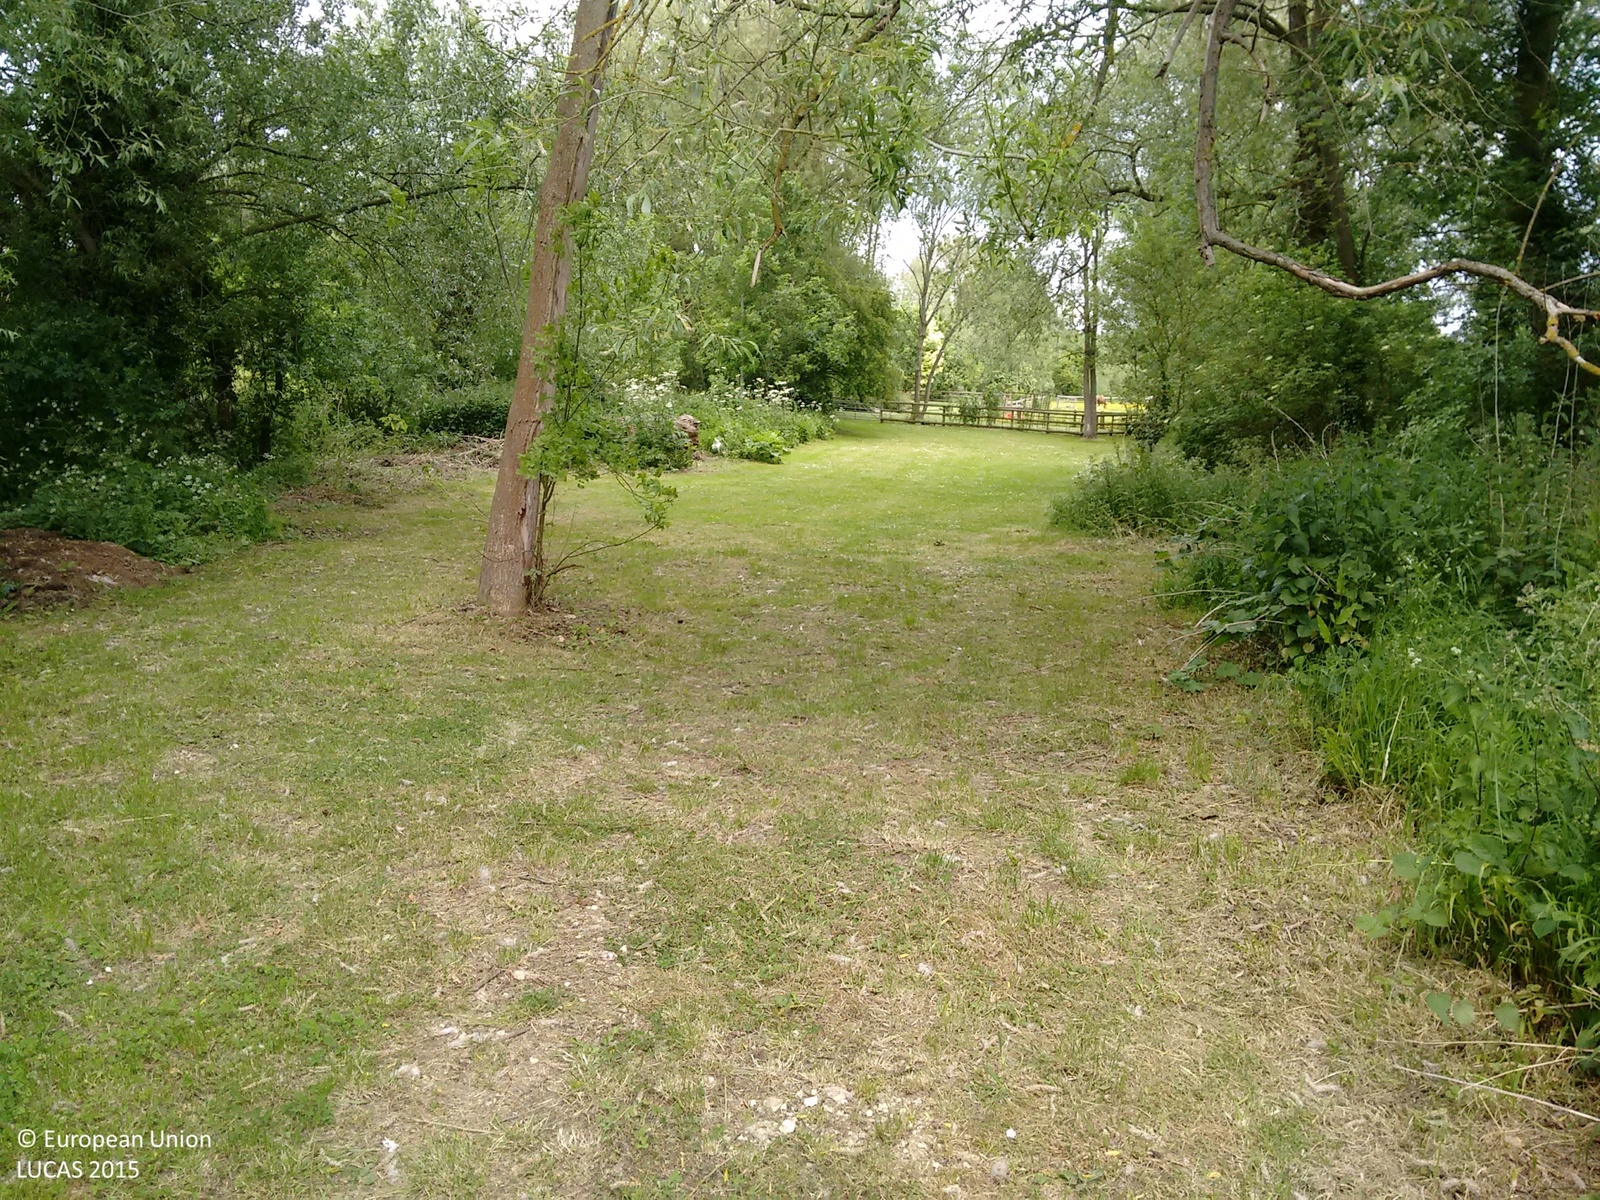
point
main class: Grassland
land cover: Grassland with sparse tree/shrub cover
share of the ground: > 75 %
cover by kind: herbaceous plants 95 %, broadleaved forest trees 5 %
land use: Agriculture (excluding fallow land and kitchen gardens)
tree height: > 5 m
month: June
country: GB
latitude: 52.1122
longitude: -1.6327
